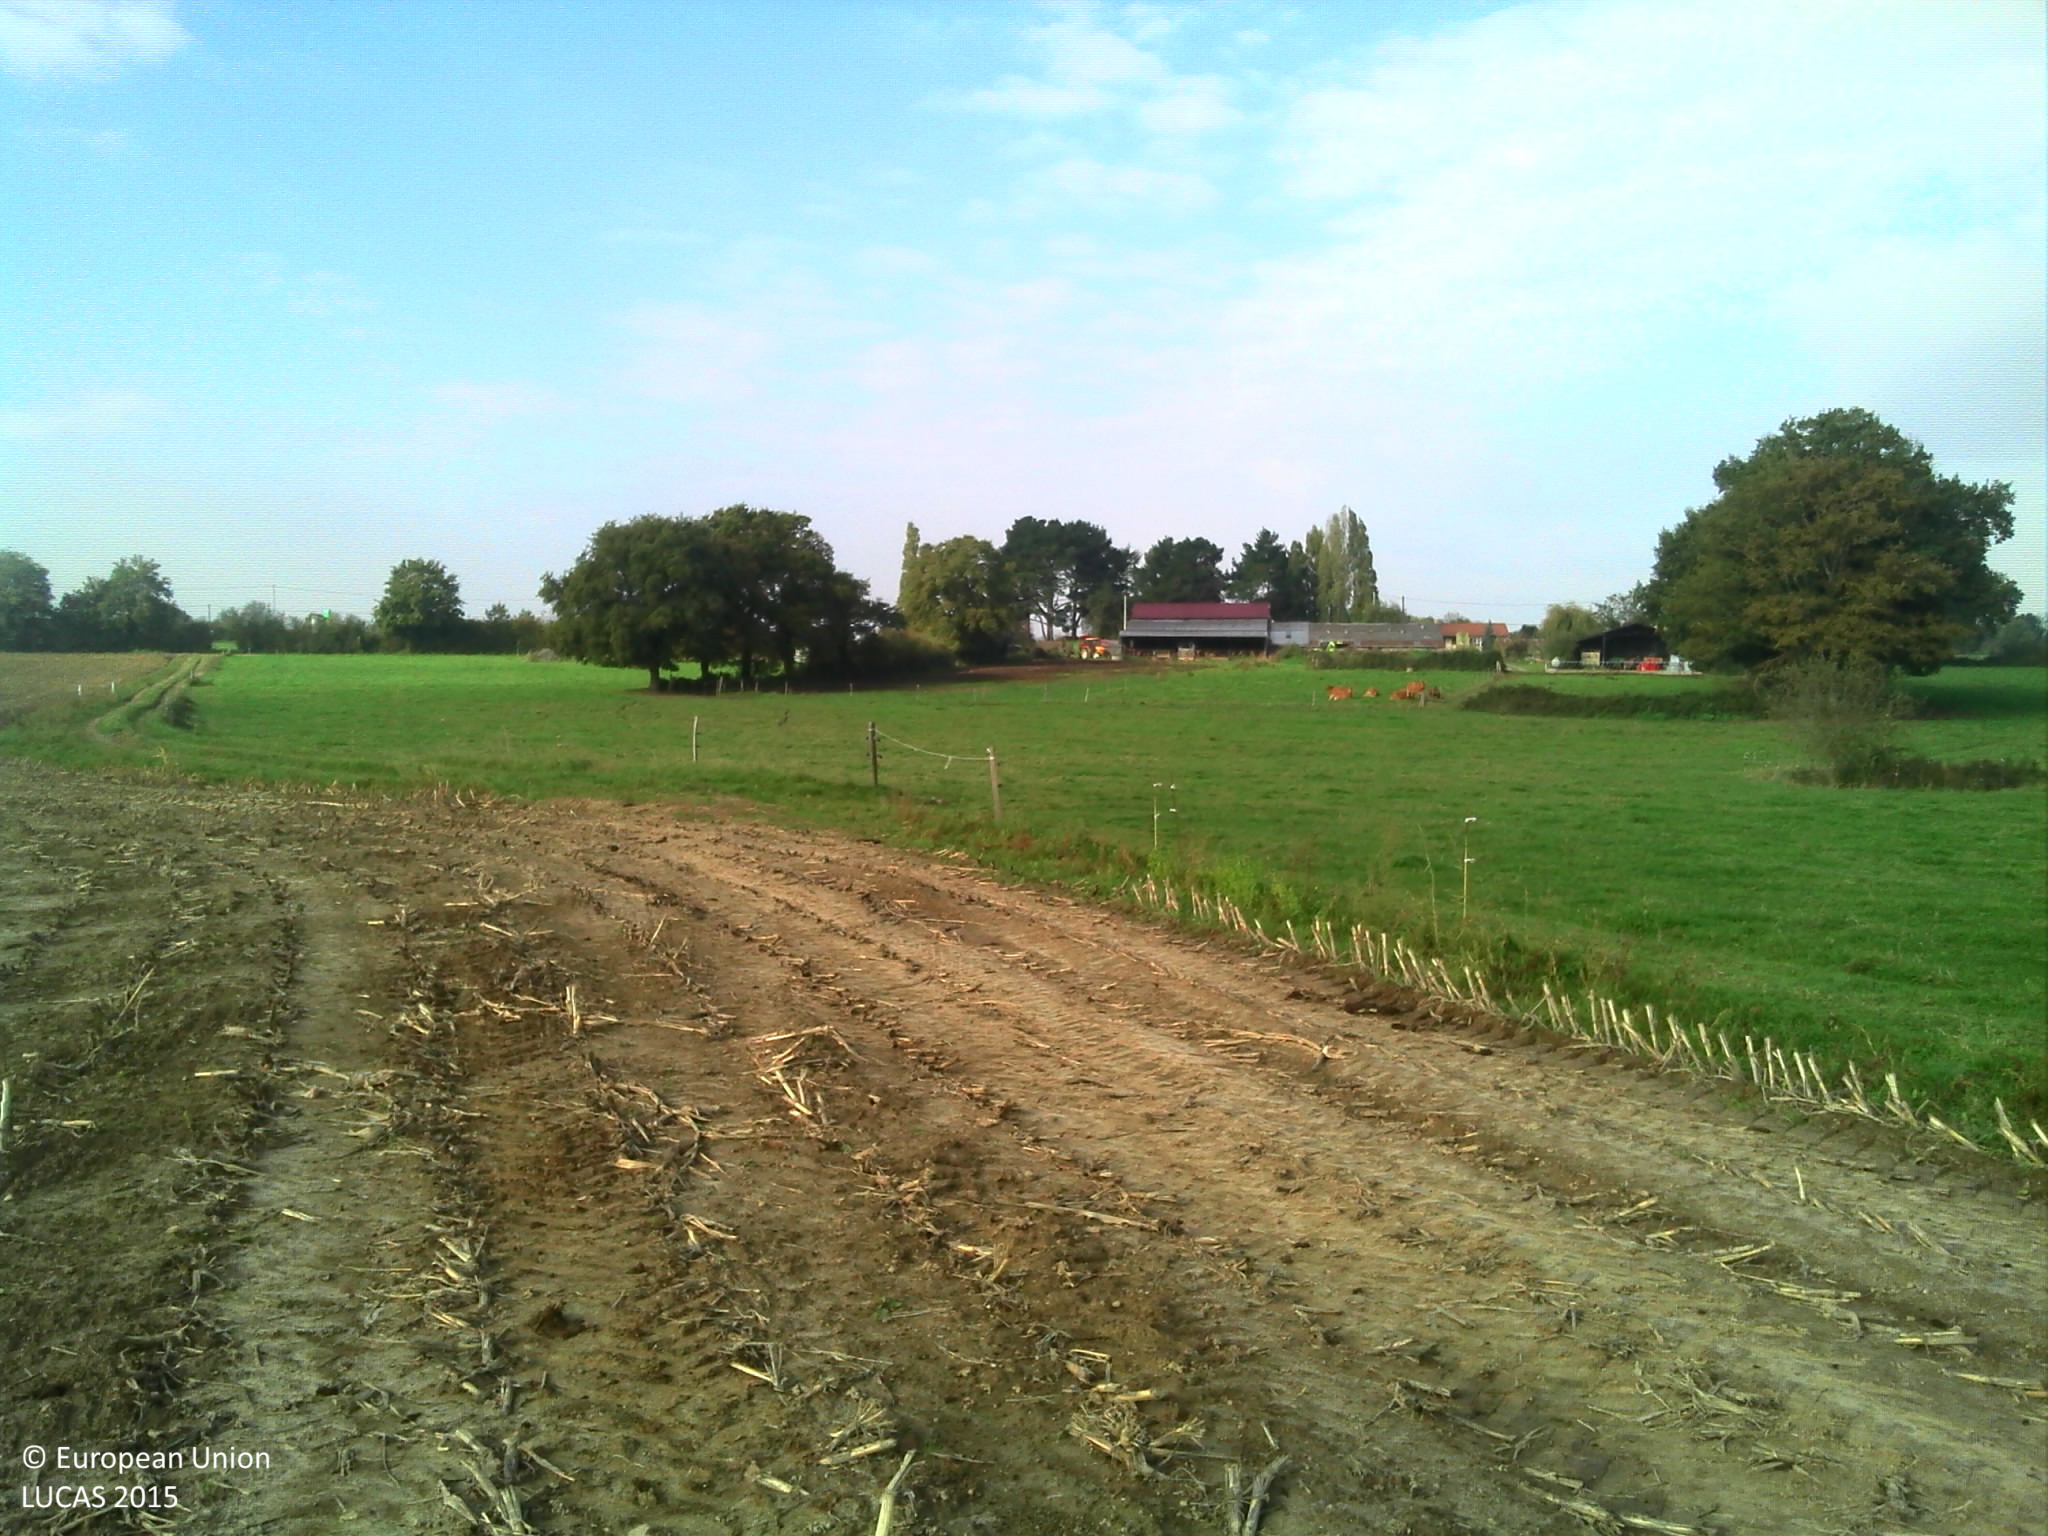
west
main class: Cropland
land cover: Maize
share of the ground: 25 - 50 %
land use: Agriculture (excluding fallow land and kitchen gardens)
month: October
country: FR
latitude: 47.1328
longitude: -0.9372
